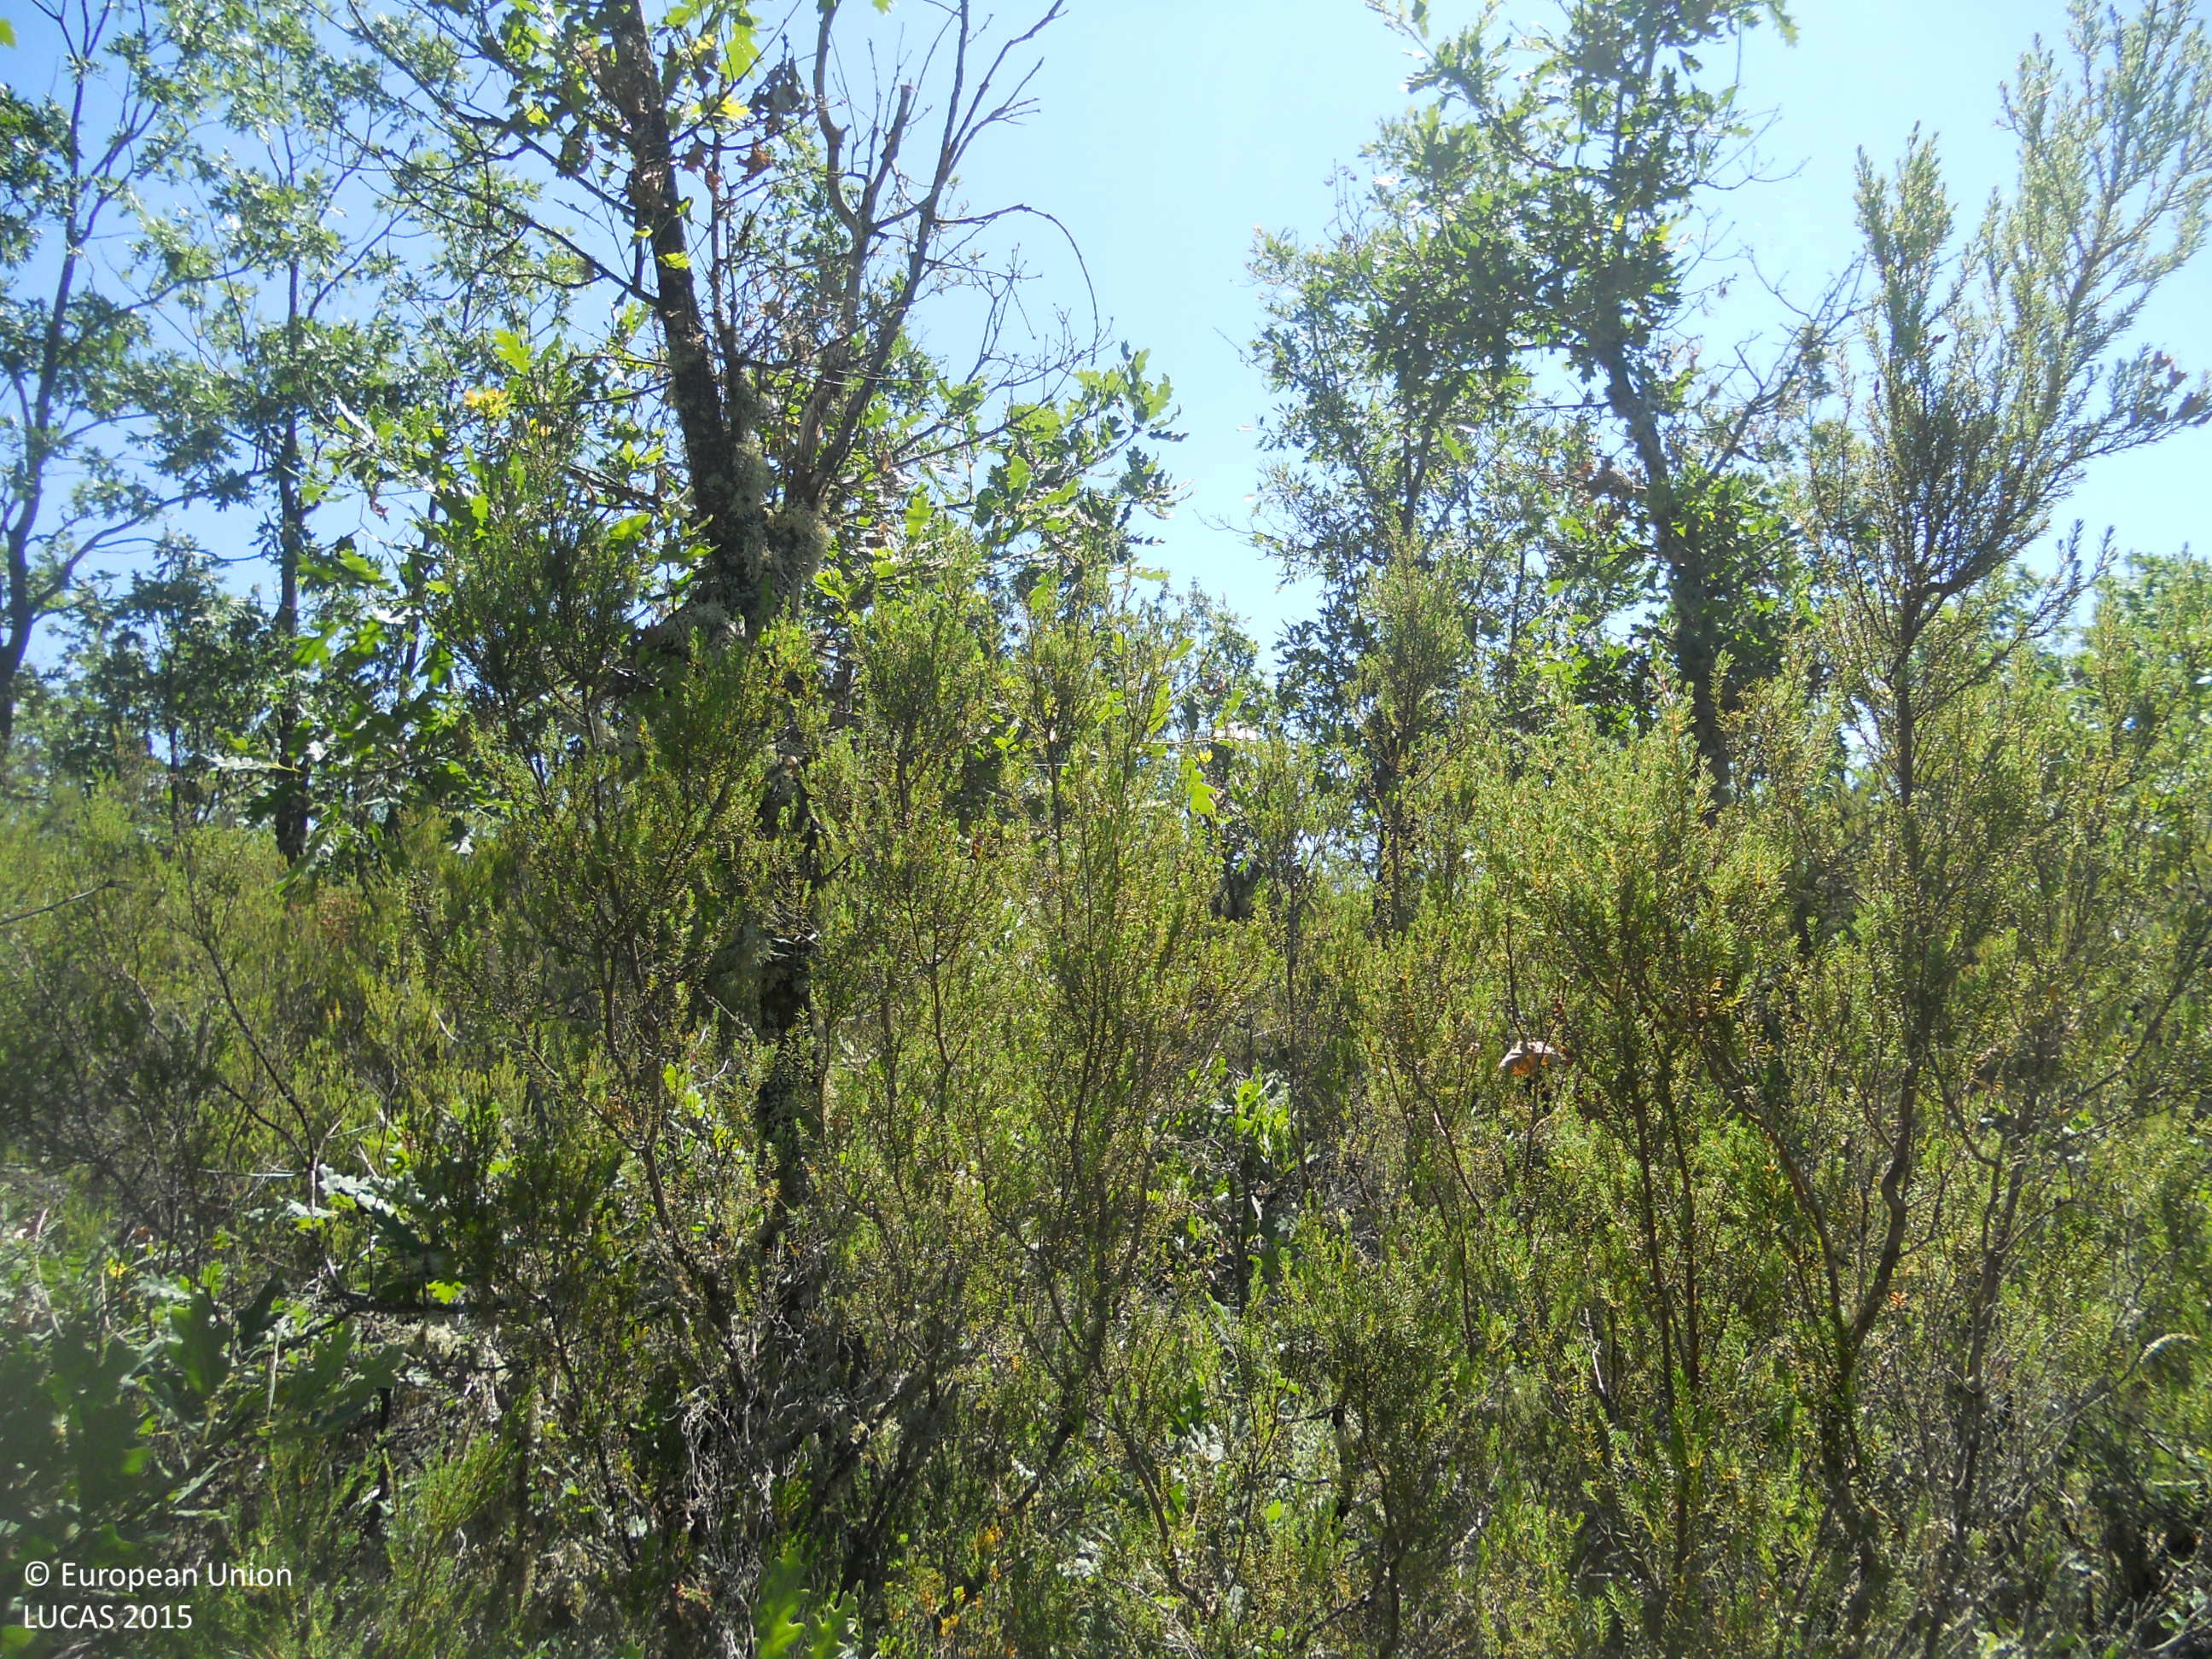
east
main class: Woodland
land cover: Broadleaved woodland
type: acidophilous oak and oak-birch forest
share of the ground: 50 - 75 %
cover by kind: broadleaved forest trees 70 %, shrubs 25 %, herbaceous plants 5 %
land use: Forestry
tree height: > 5 m
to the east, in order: Broadleaved woodland; Shrubland with sparse tree cover; Broadleaved woodland
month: June
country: ES
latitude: 42.6194
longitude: -4.9467
